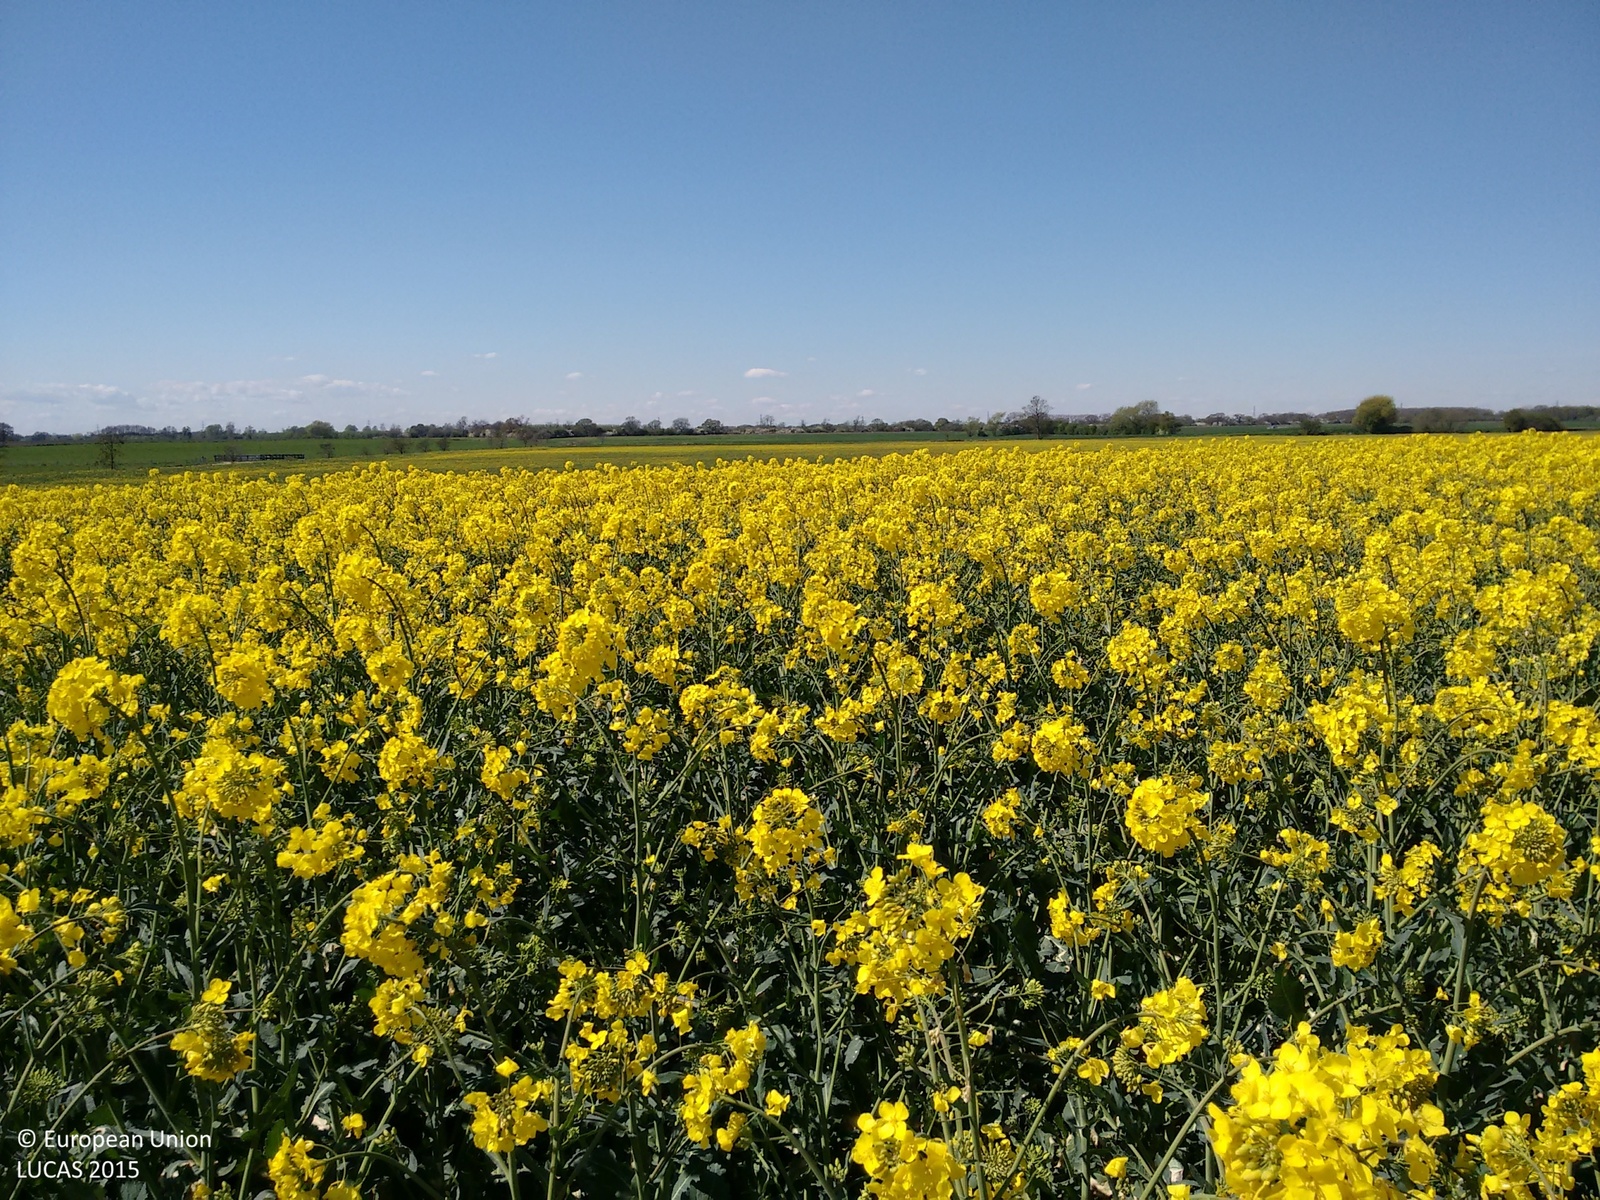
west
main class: Cropland
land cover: Rape and turnip rape
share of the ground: > 75 %
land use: Agriculture (excluding fallow land and kitchen gardens)
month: April
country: GB
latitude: 53.8237
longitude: -0.8113
